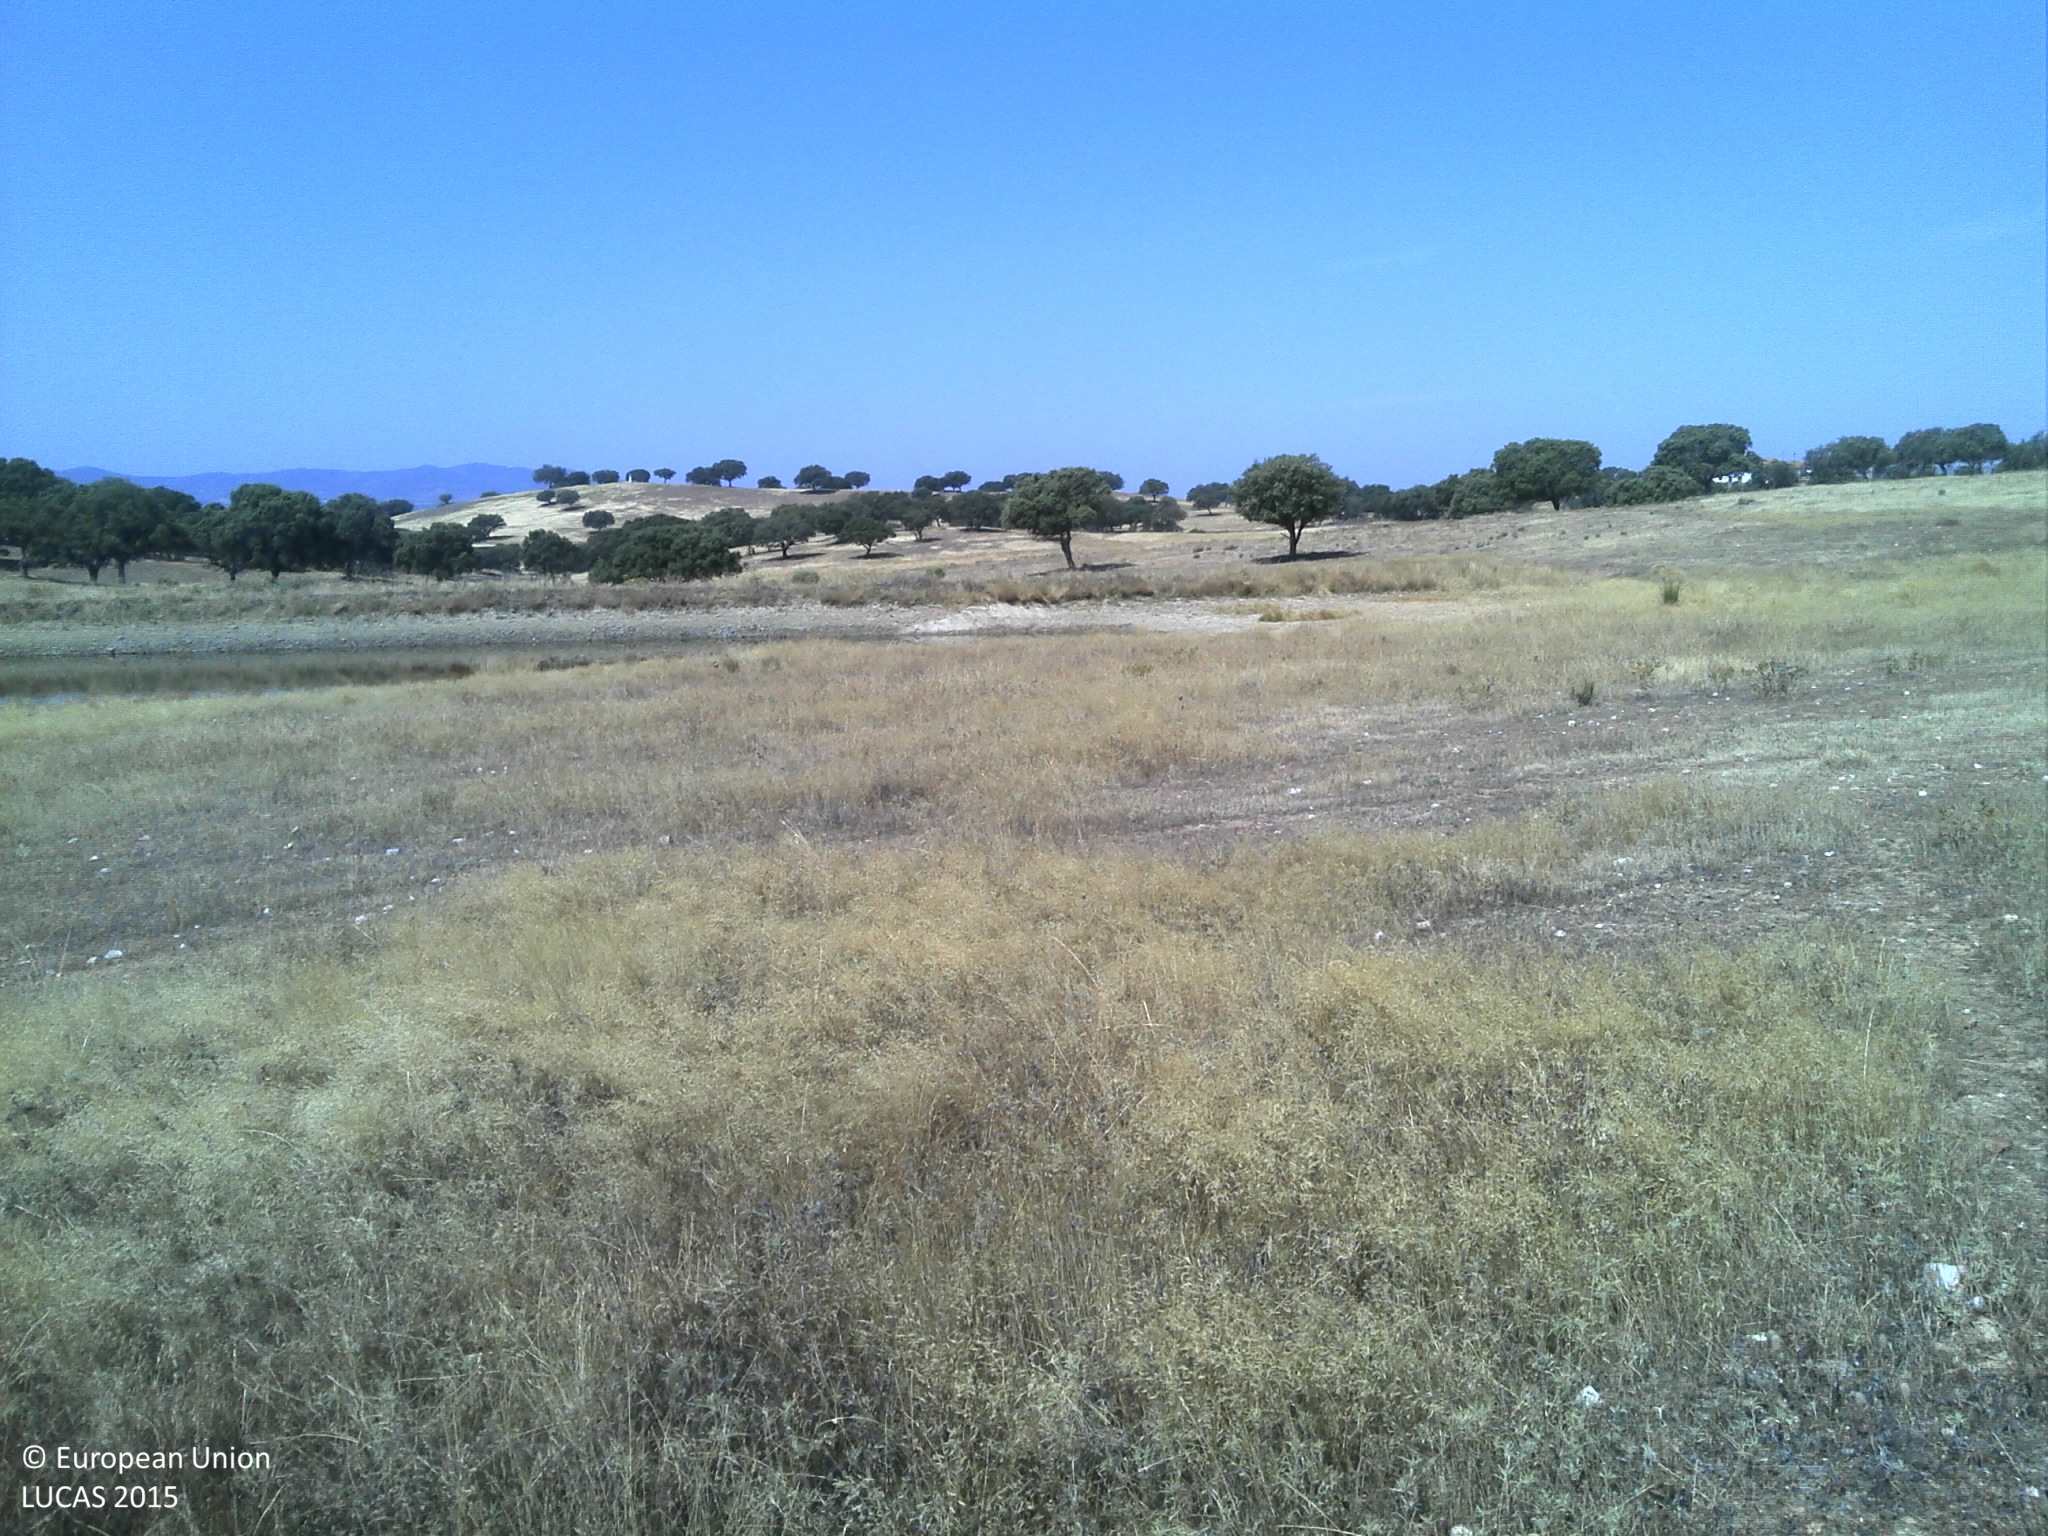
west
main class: Grassland
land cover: Grassland without tree/shrub cover
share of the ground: > 75 %
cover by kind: herbaceous plants 80 %, unconsolidated bare surface 10 %, shrubs 5 %
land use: Agriculture (excluding fallow land and kitchen gardens)
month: June
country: PT
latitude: 39.6803
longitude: -7.0739
